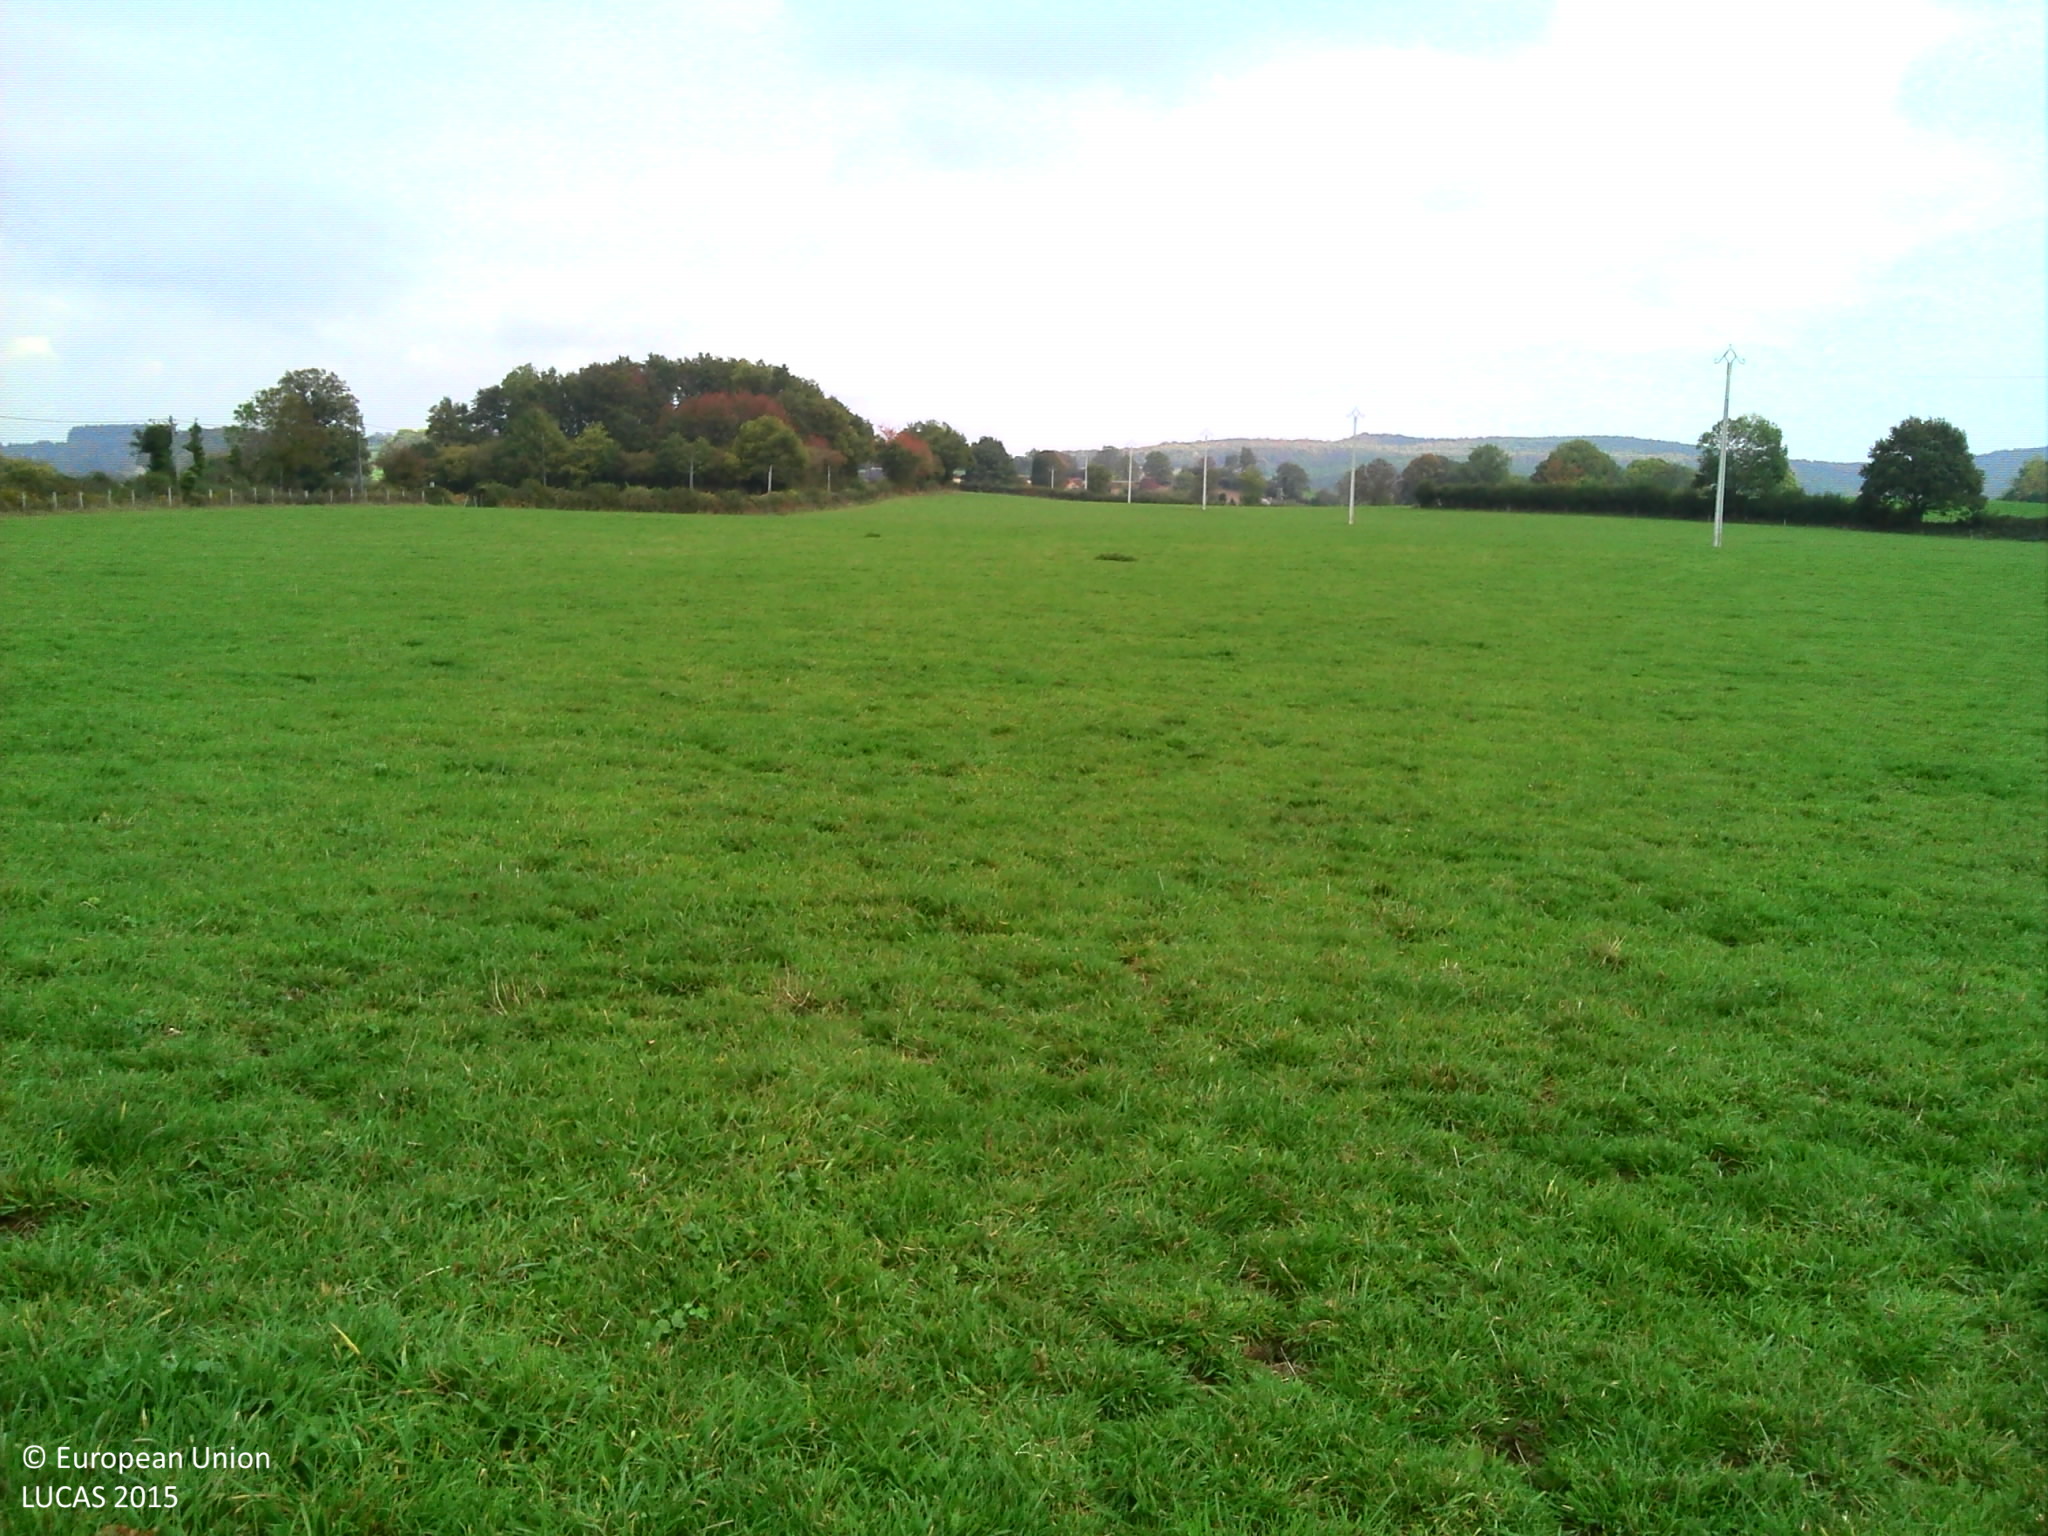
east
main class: Grassland
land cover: Grassland without tree/shrub cover
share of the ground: > 75 %
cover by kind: herbaceous plants 100 %
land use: Agriculture (excluding fallow land and kitchen gardens)
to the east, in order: Grassland without tree/shrub cover
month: October
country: FR
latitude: 46.1598
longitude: 2.7583
